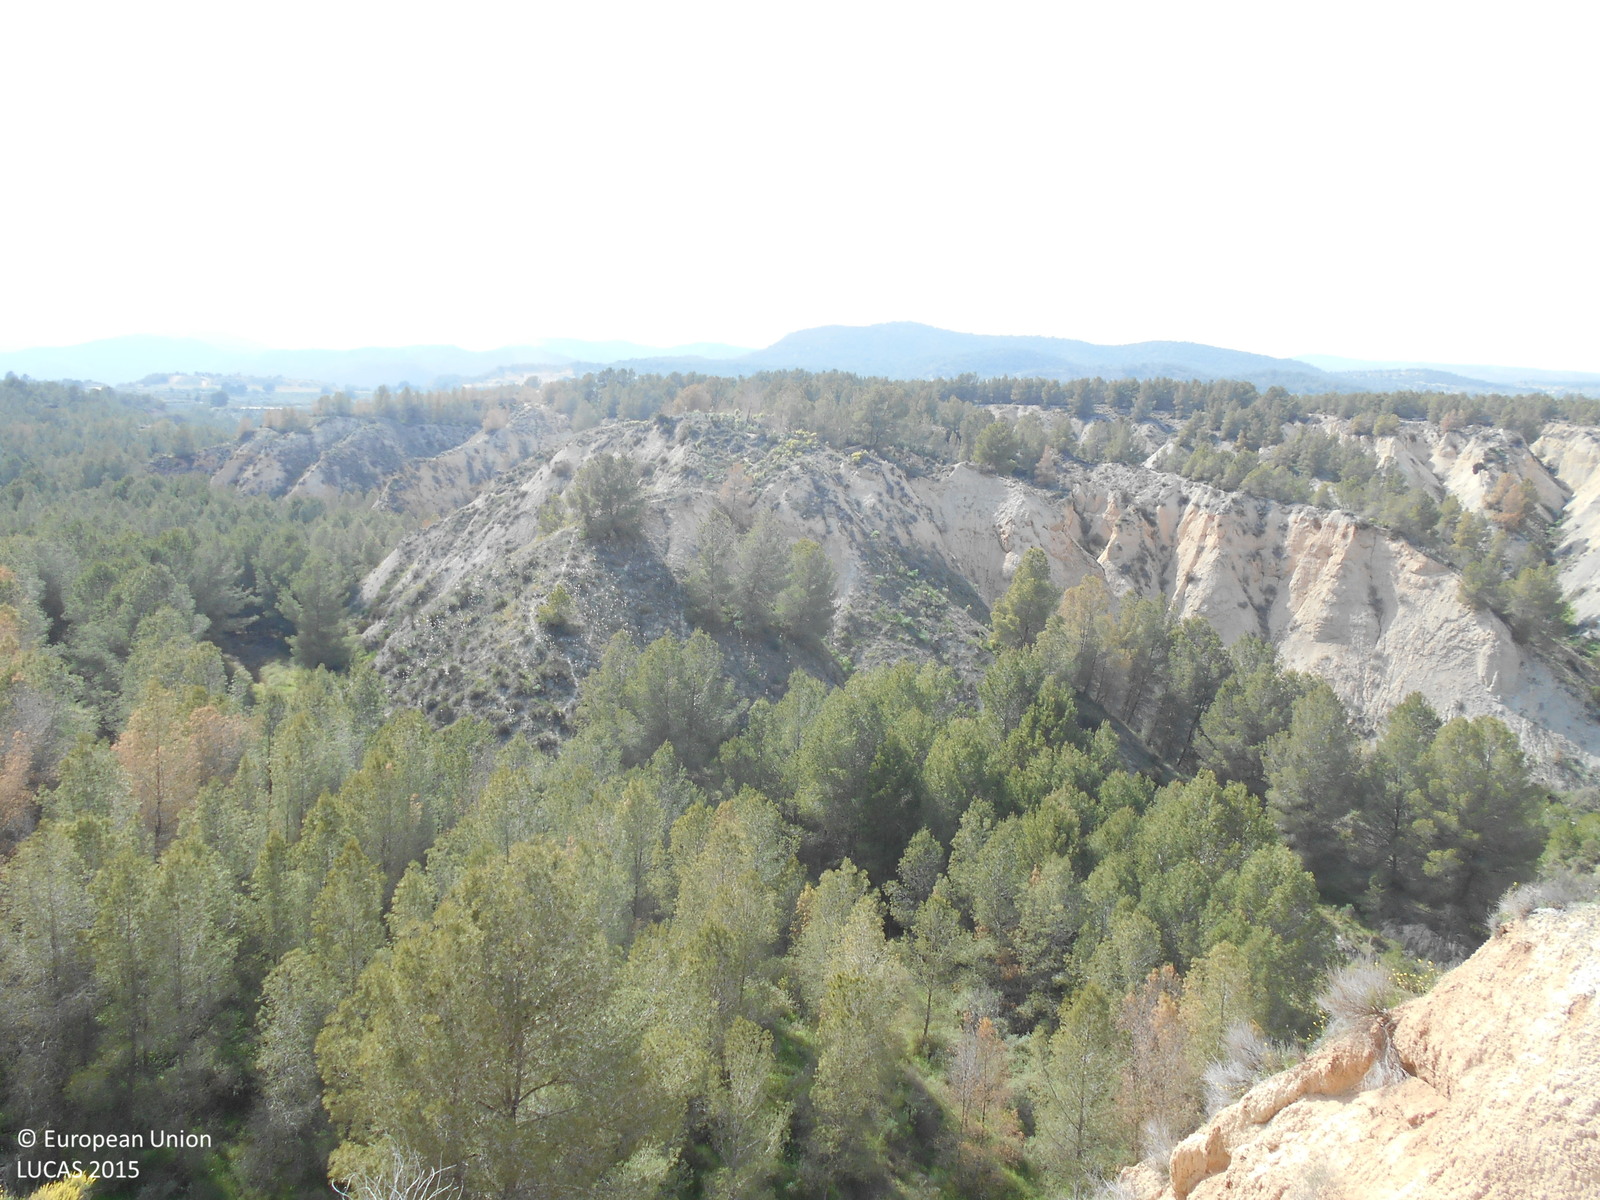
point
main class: Woodland
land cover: Pine dominated coniferous woodland
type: coniferous forest of the mediterranean region
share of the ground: 25 - 50 %
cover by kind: shrubs 40 %, coniferous forest trees 30 %, herbaceous plants 20 %, unconsolidated bare surface 10 %
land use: Semi-natural and natural areas not in use
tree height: > 5 m
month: April
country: ES
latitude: 37.8790
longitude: -1.4328
